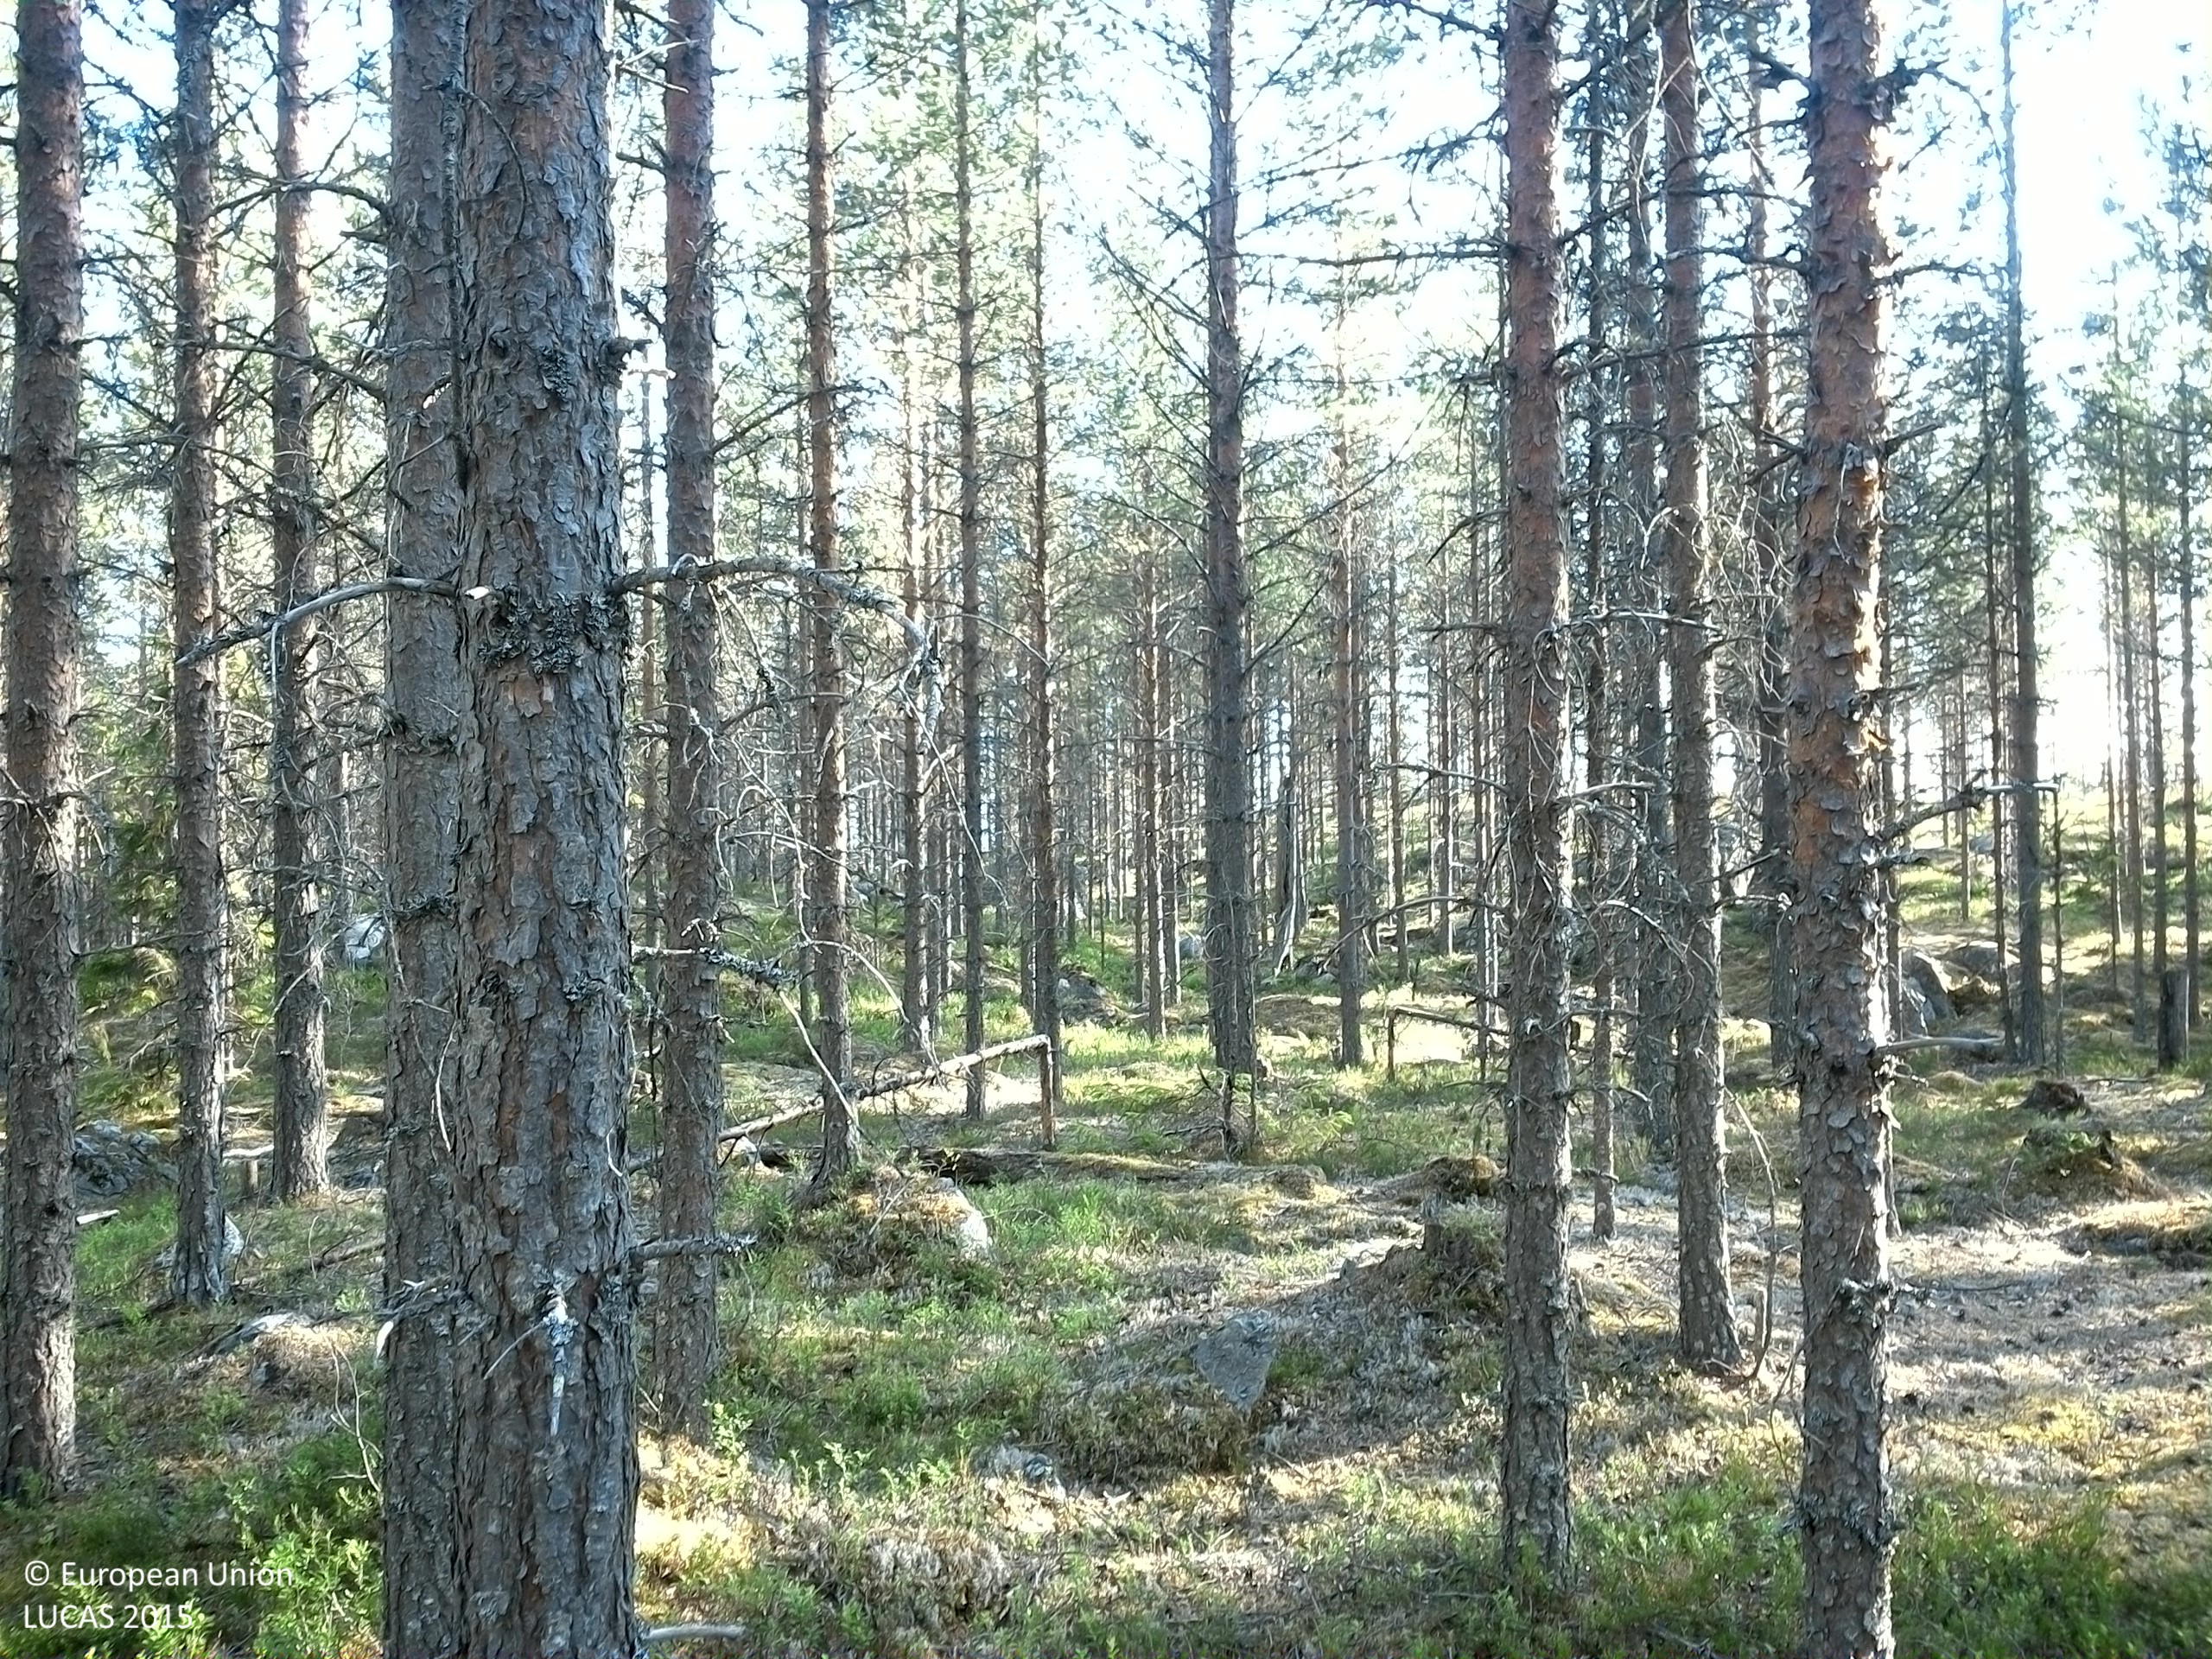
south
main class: Woodland
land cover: Pine dominated coniferous woodland
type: boreal forest
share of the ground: > 75 %
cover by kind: coniferous forest trees 75 %, lichens and mosses 20 %, shrubs 5 %
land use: Forestry
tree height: > 5 m
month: July
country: SE
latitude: 63.6182
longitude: 17.5778
